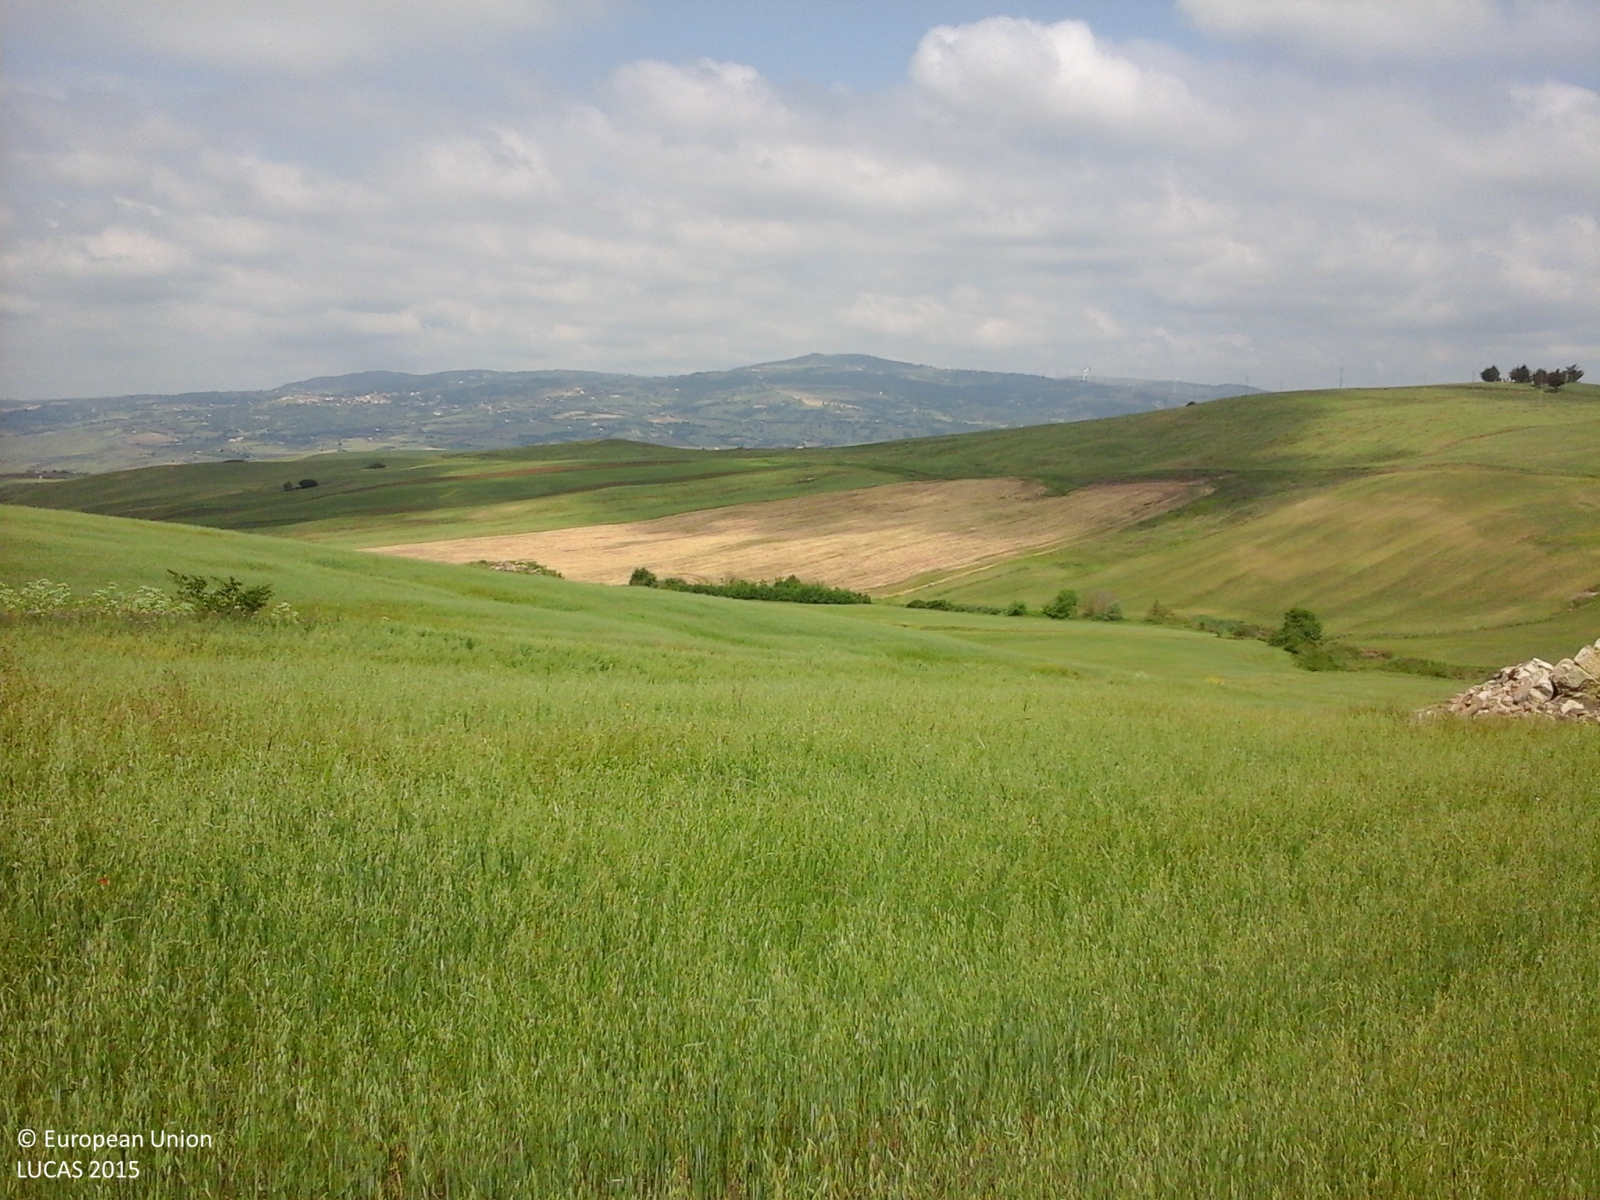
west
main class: Cropland
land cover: Oats
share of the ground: > 75 %
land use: Agriculture (excluding fallow land and kitchen gardens)
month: May
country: IT
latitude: 41.2221
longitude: 15.0990
